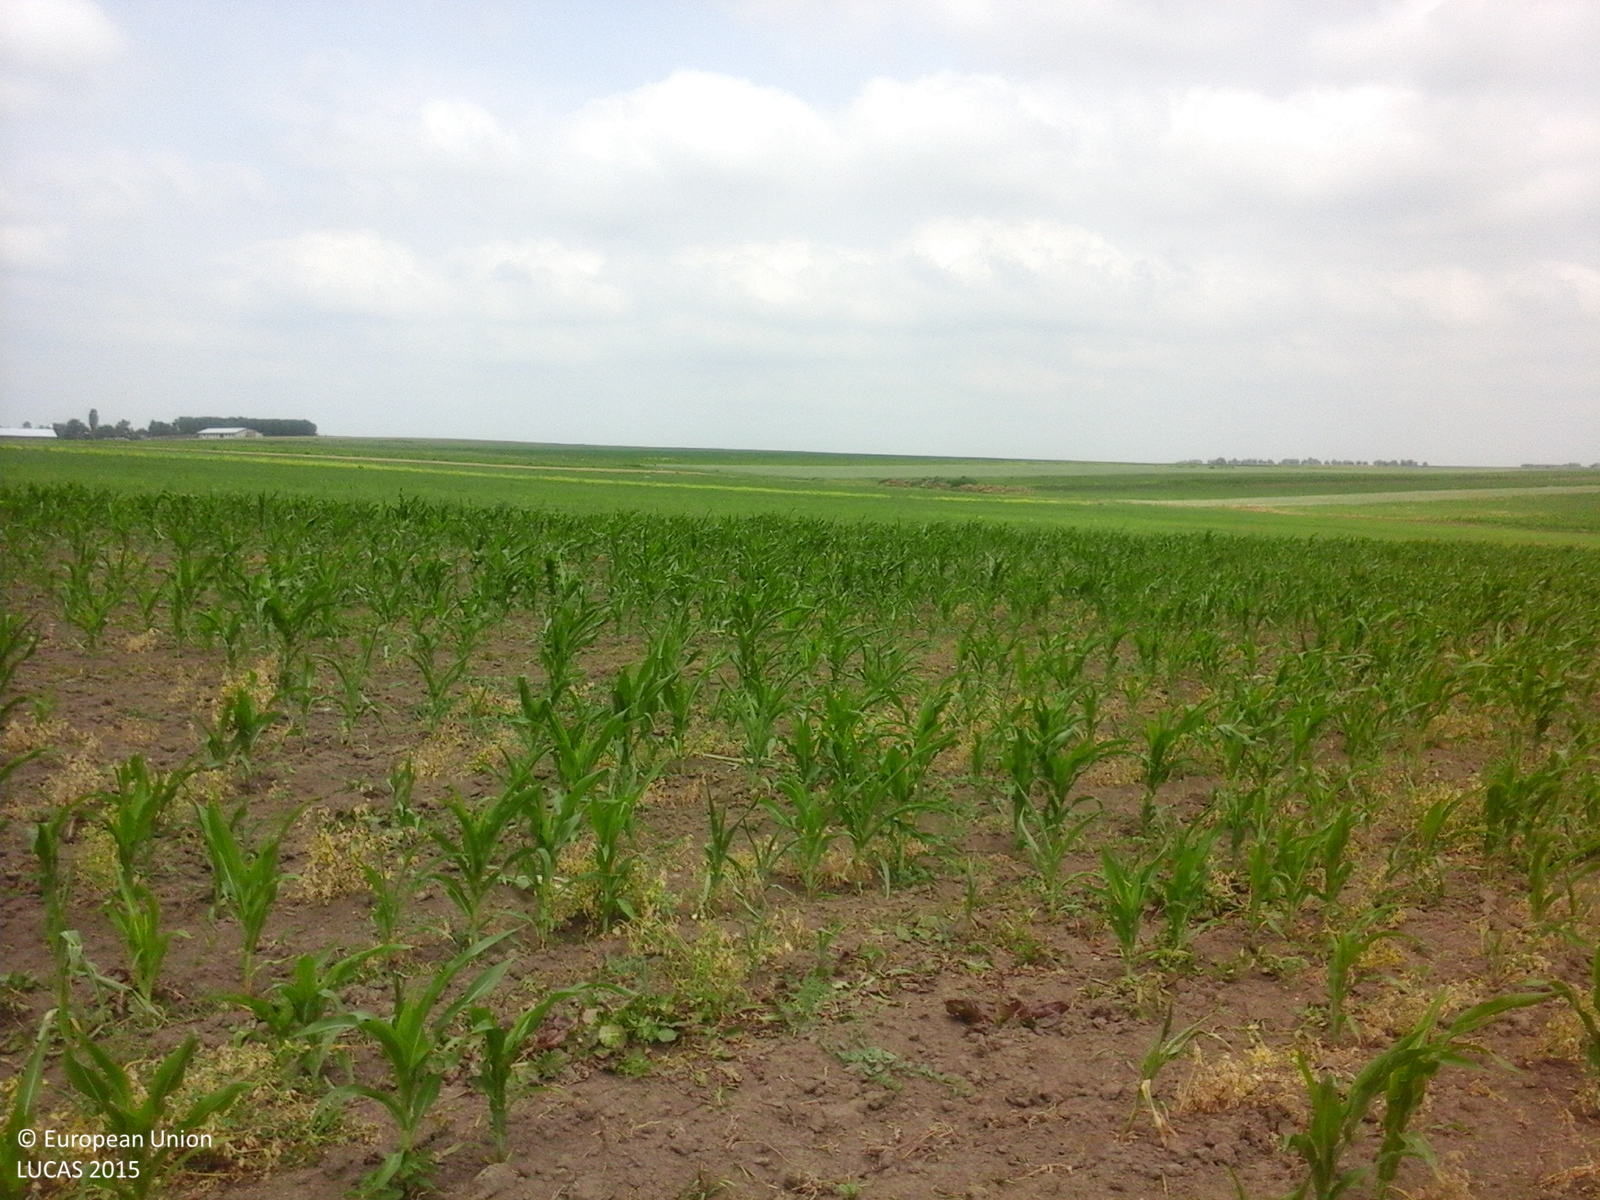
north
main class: Cropland
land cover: Maize
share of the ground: 25 - 50 %
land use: Agriculture (excluding fallow land and kitchen gardens)
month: June
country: RO
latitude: 47.8372
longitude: 26.7042
